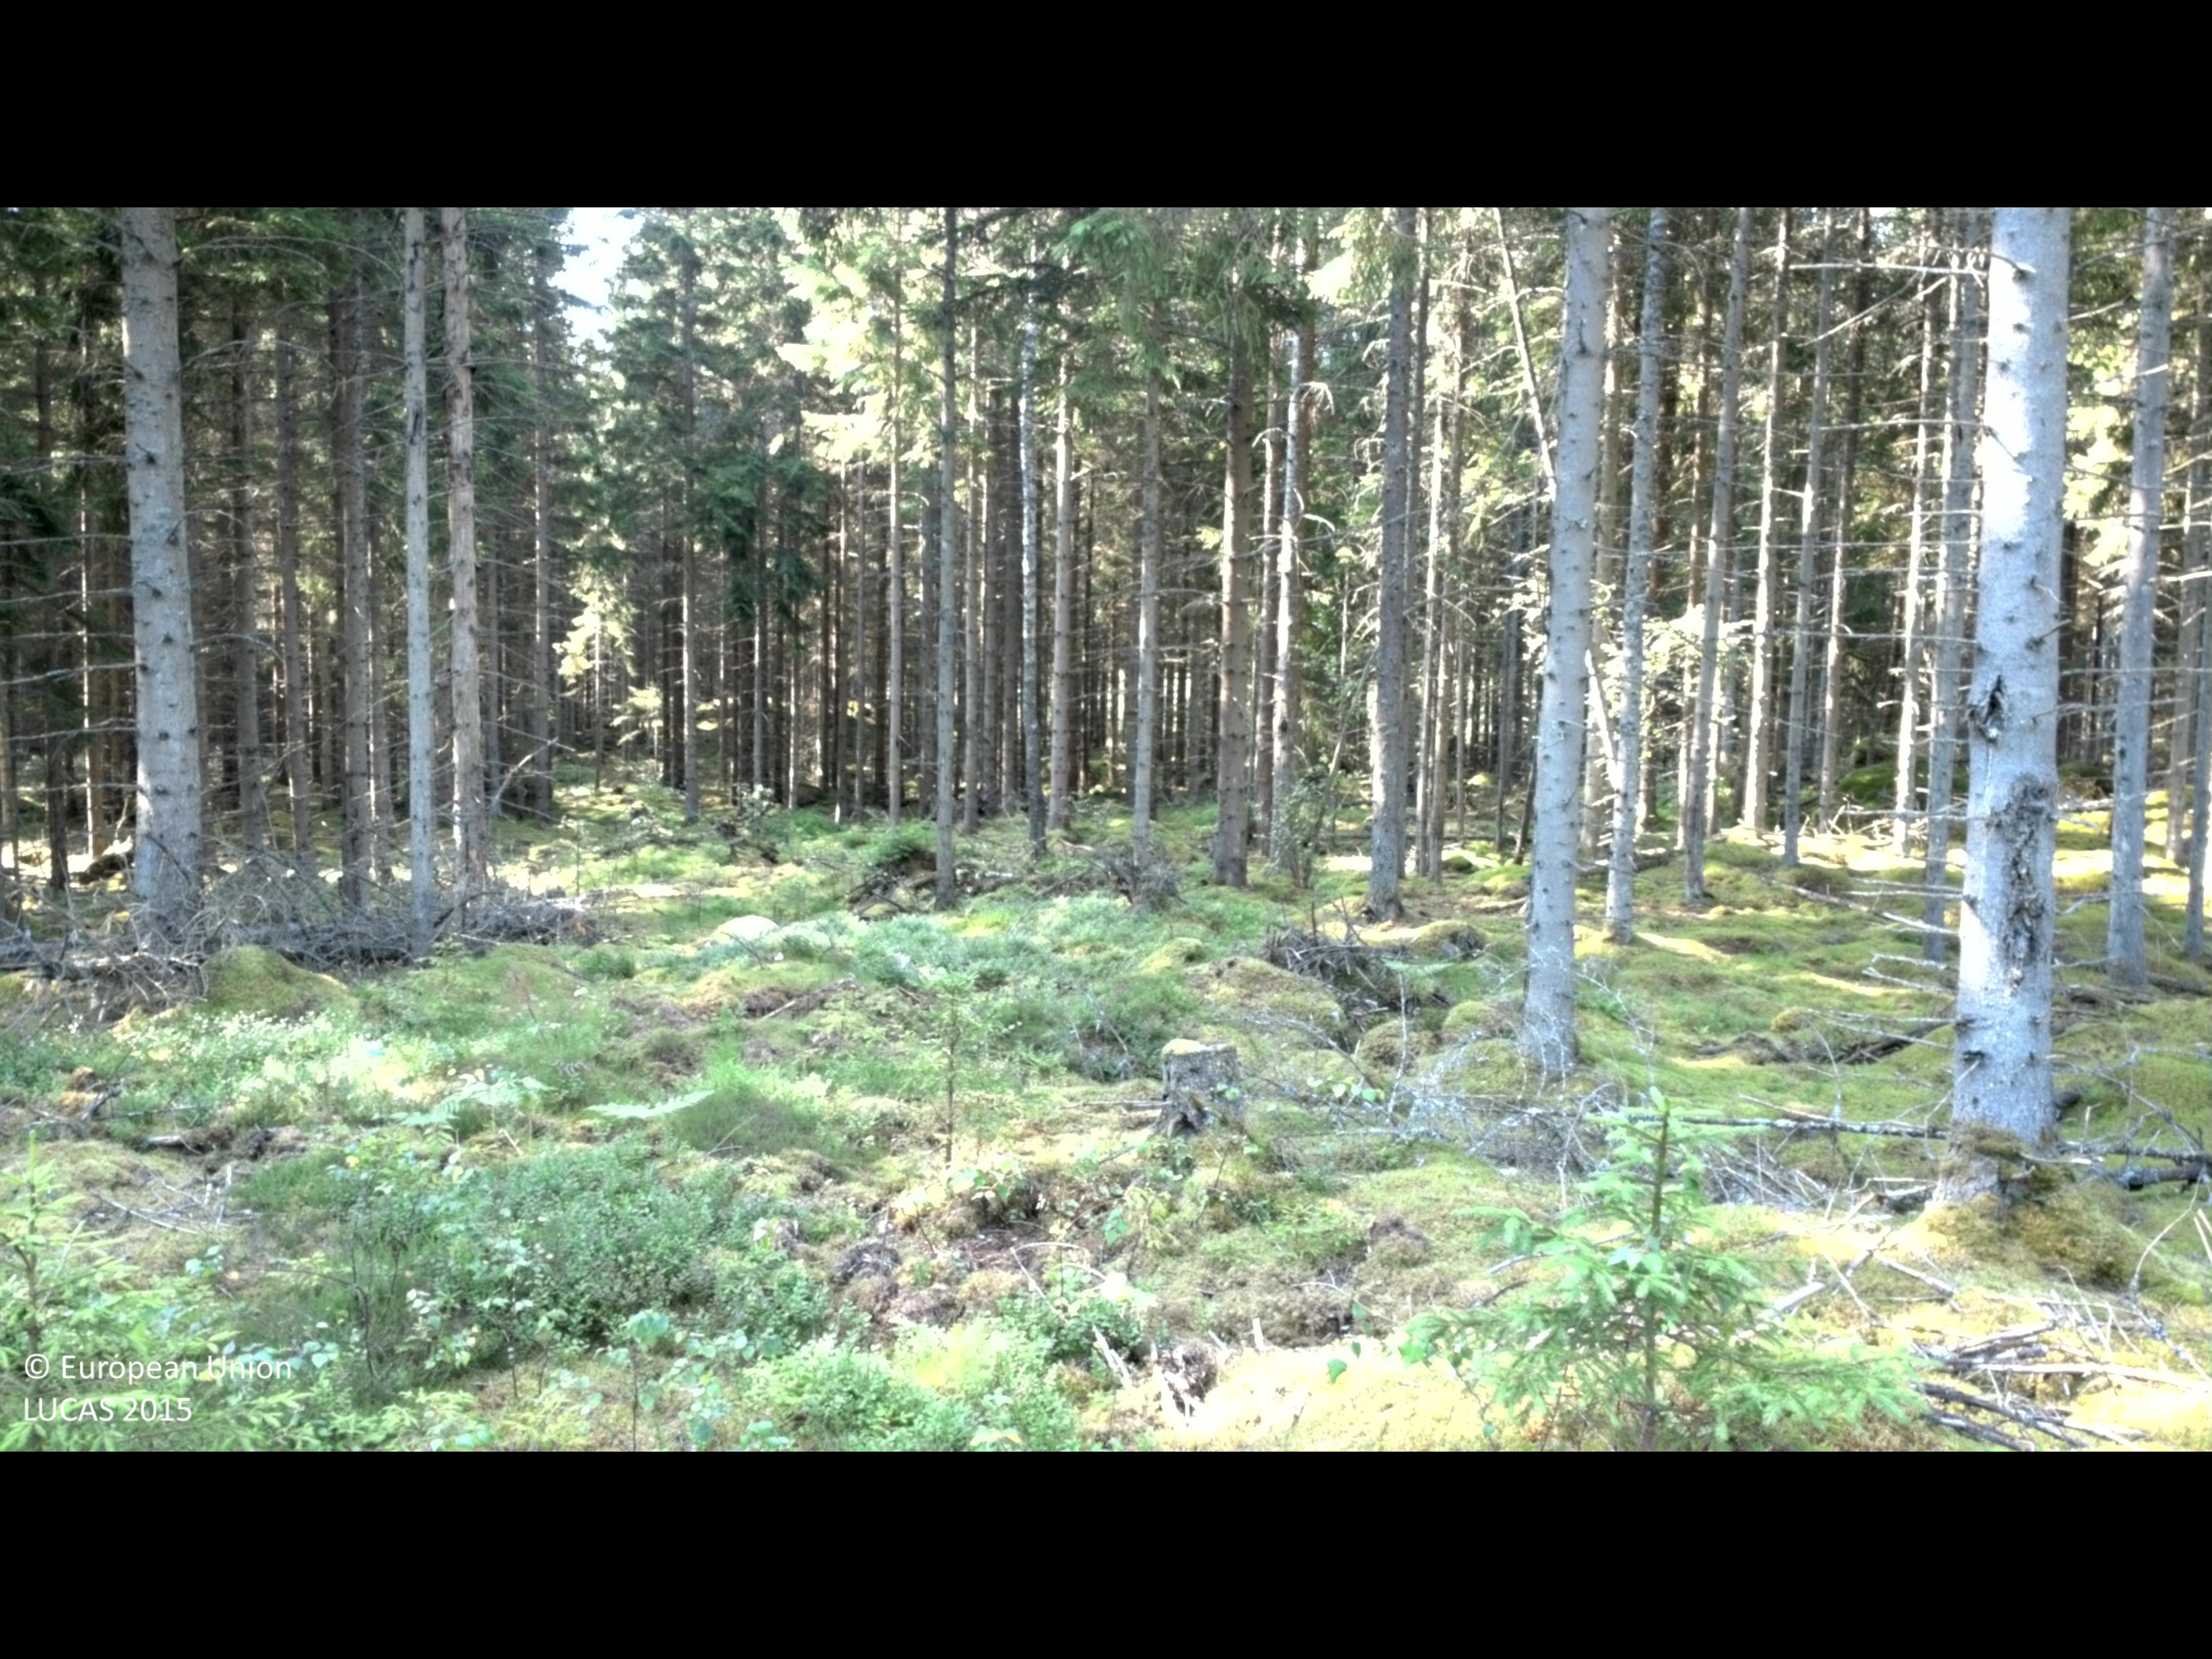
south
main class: Woodland
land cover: Spruce dominated coniferous woodland
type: boreal forest
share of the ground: 50 - 75 %
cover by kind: coniferous forest trees 70 %, lichens and mosses 20 %, shrubs 10 %
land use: Forestry
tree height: > 5 m
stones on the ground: 25 - 50 %
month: August
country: SE
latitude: 56.6457
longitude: 14.0576
